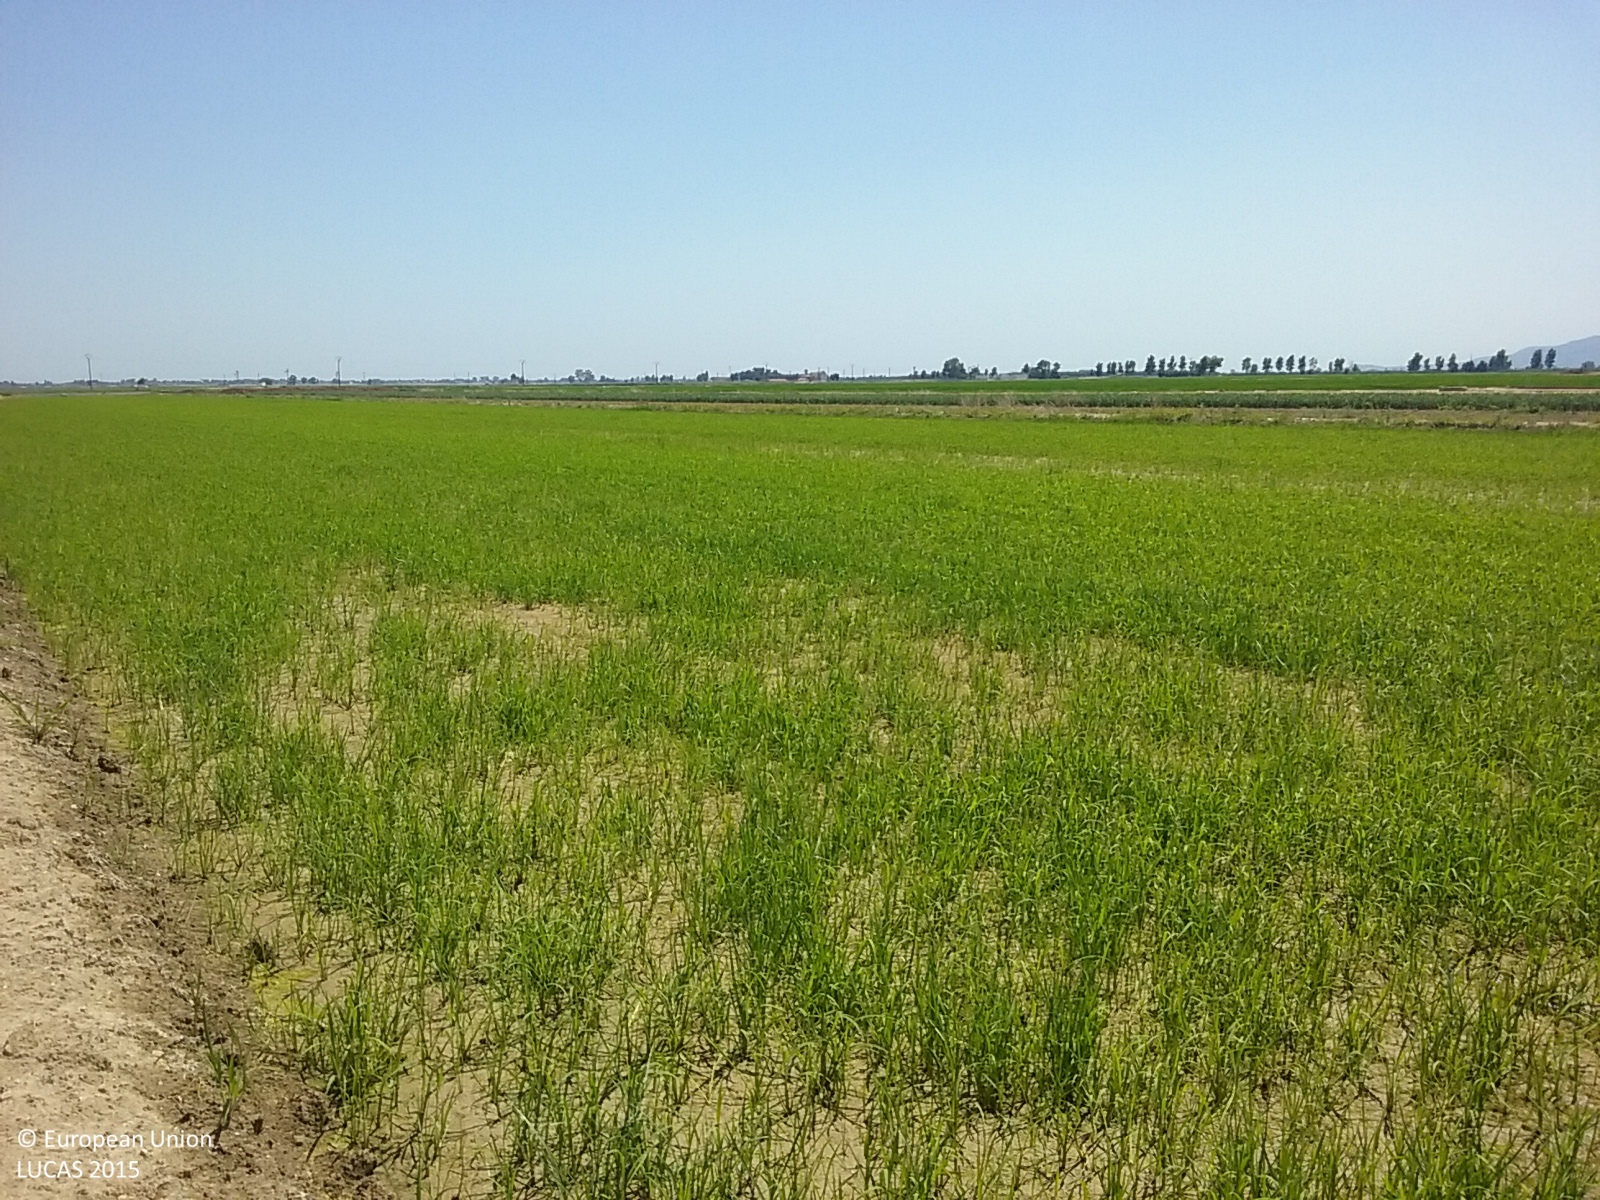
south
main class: Cropland
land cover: Rice
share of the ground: 50 - 75 %
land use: Agriculture (excluding fallow land and kitchen gardens)
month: June
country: ES
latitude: 40.7682
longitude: 0.6711
